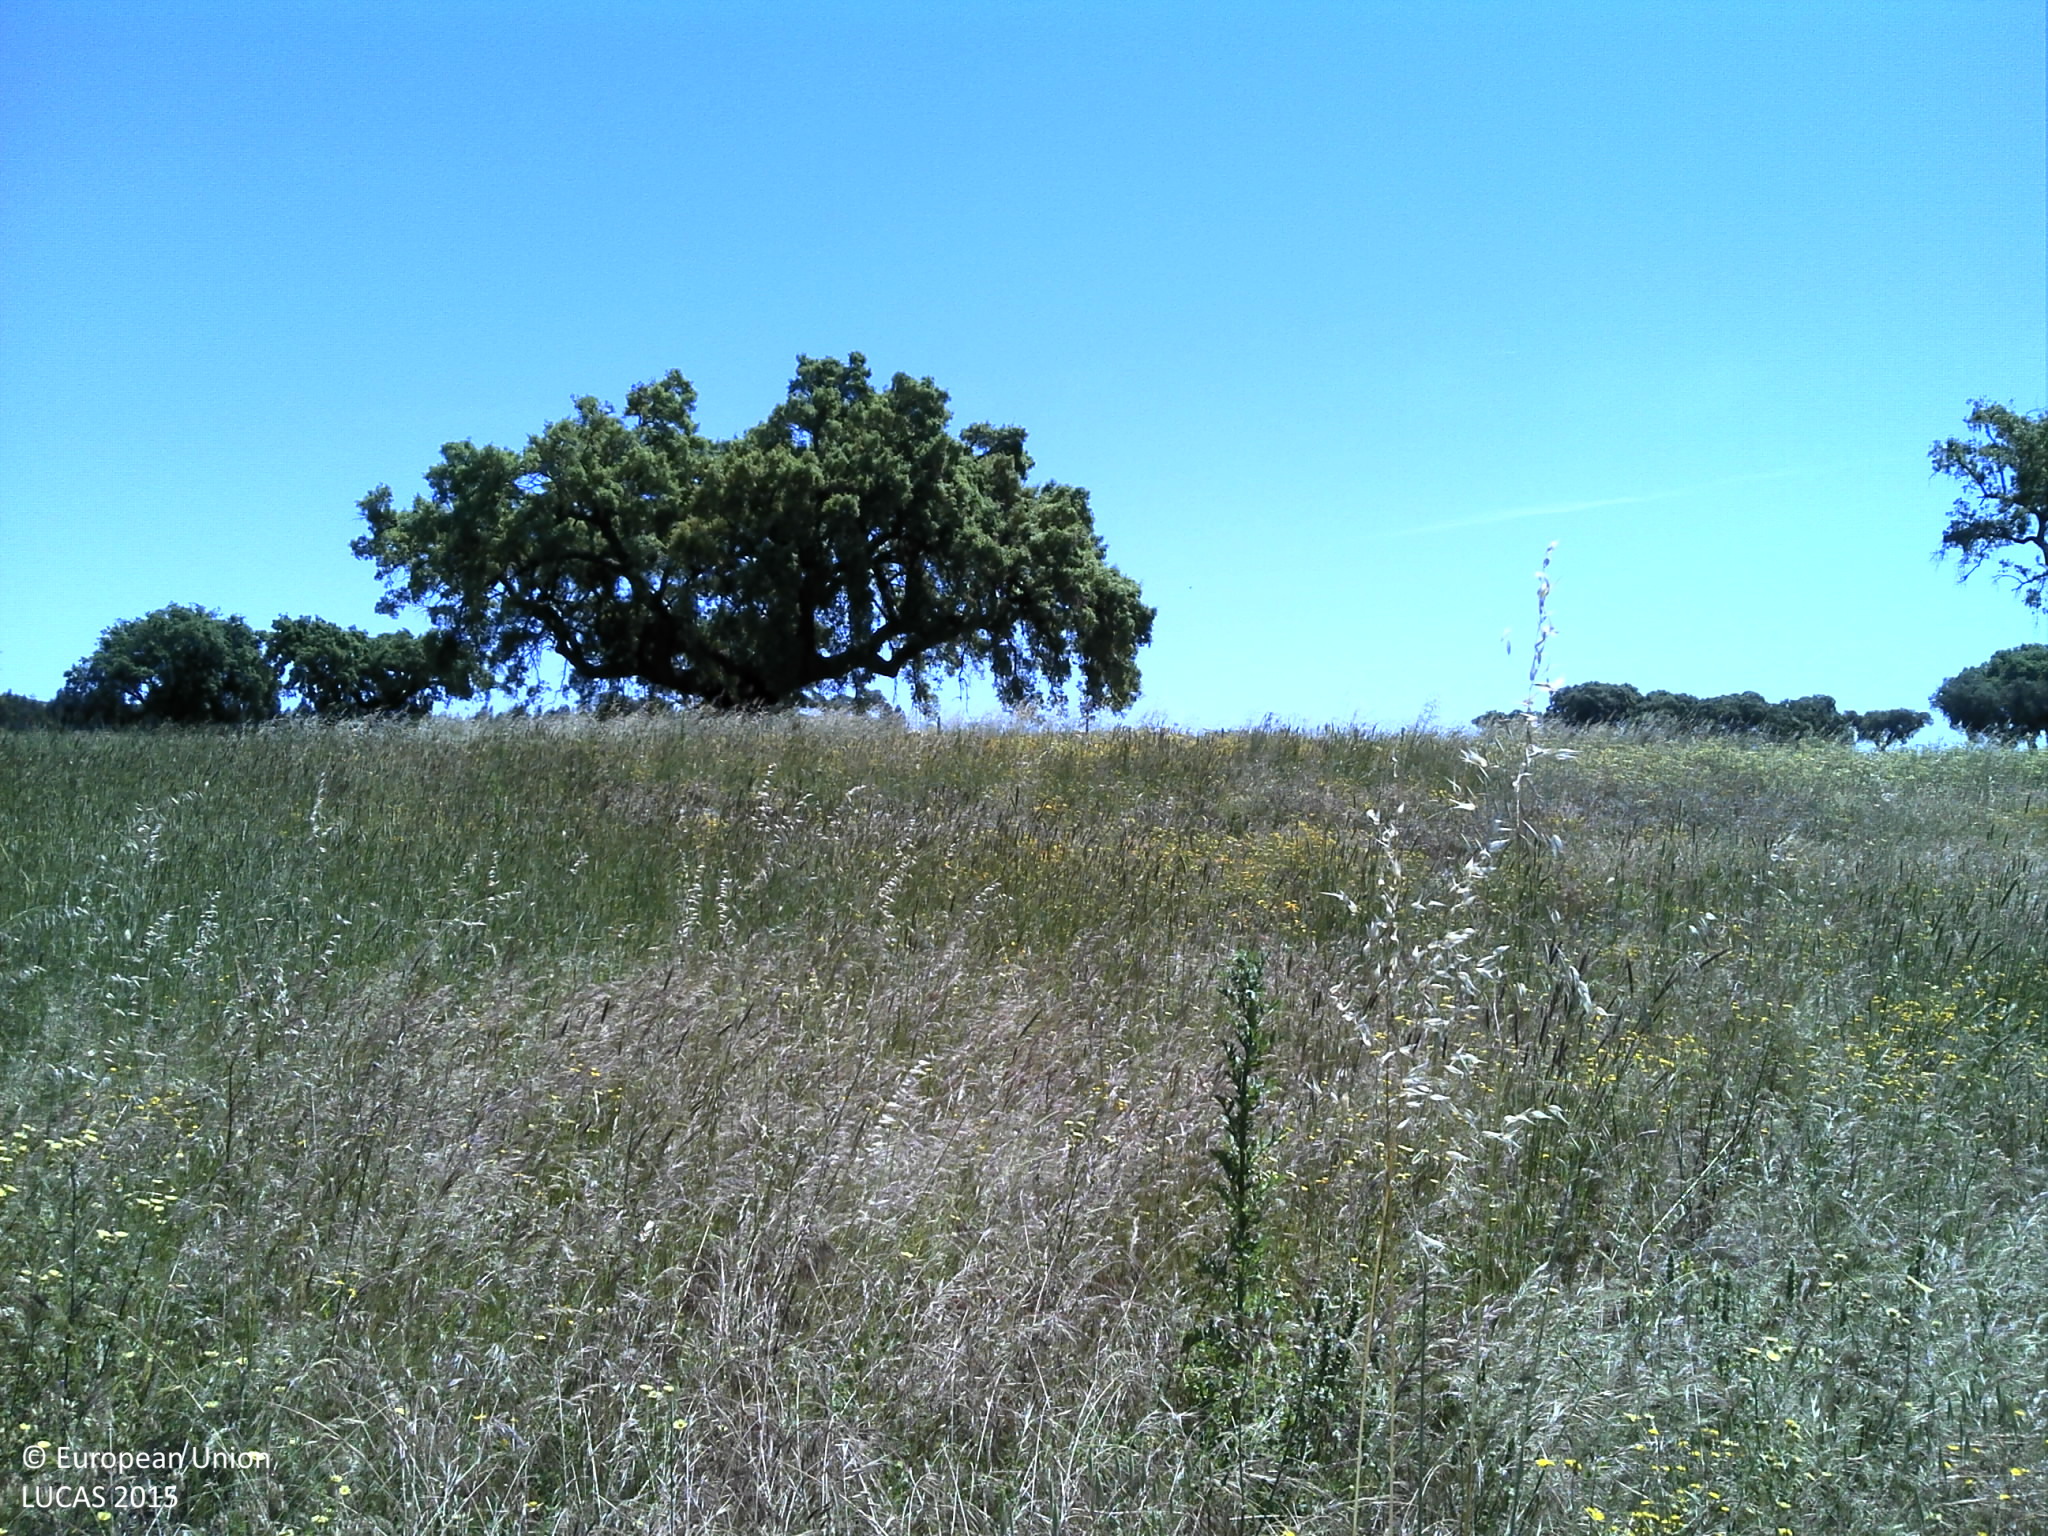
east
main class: Grassland
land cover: Grassland with sparse tree/shrub cover
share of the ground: > 75 %
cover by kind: herbaceous plants 90 %, broadleaved forest trees 5 %, unconsolidated bare surface 5 %
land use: Agriculture (excluding fallow land and kitchen gardens)
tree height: > 5 m
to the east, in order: Grassland with sparse tree/shrub cover; Grassland without tree/shrub cover; Single bushes/trees; Grassland without tree/shrub cover
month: May
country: PT
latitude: 39.2026
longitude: -7.8718
